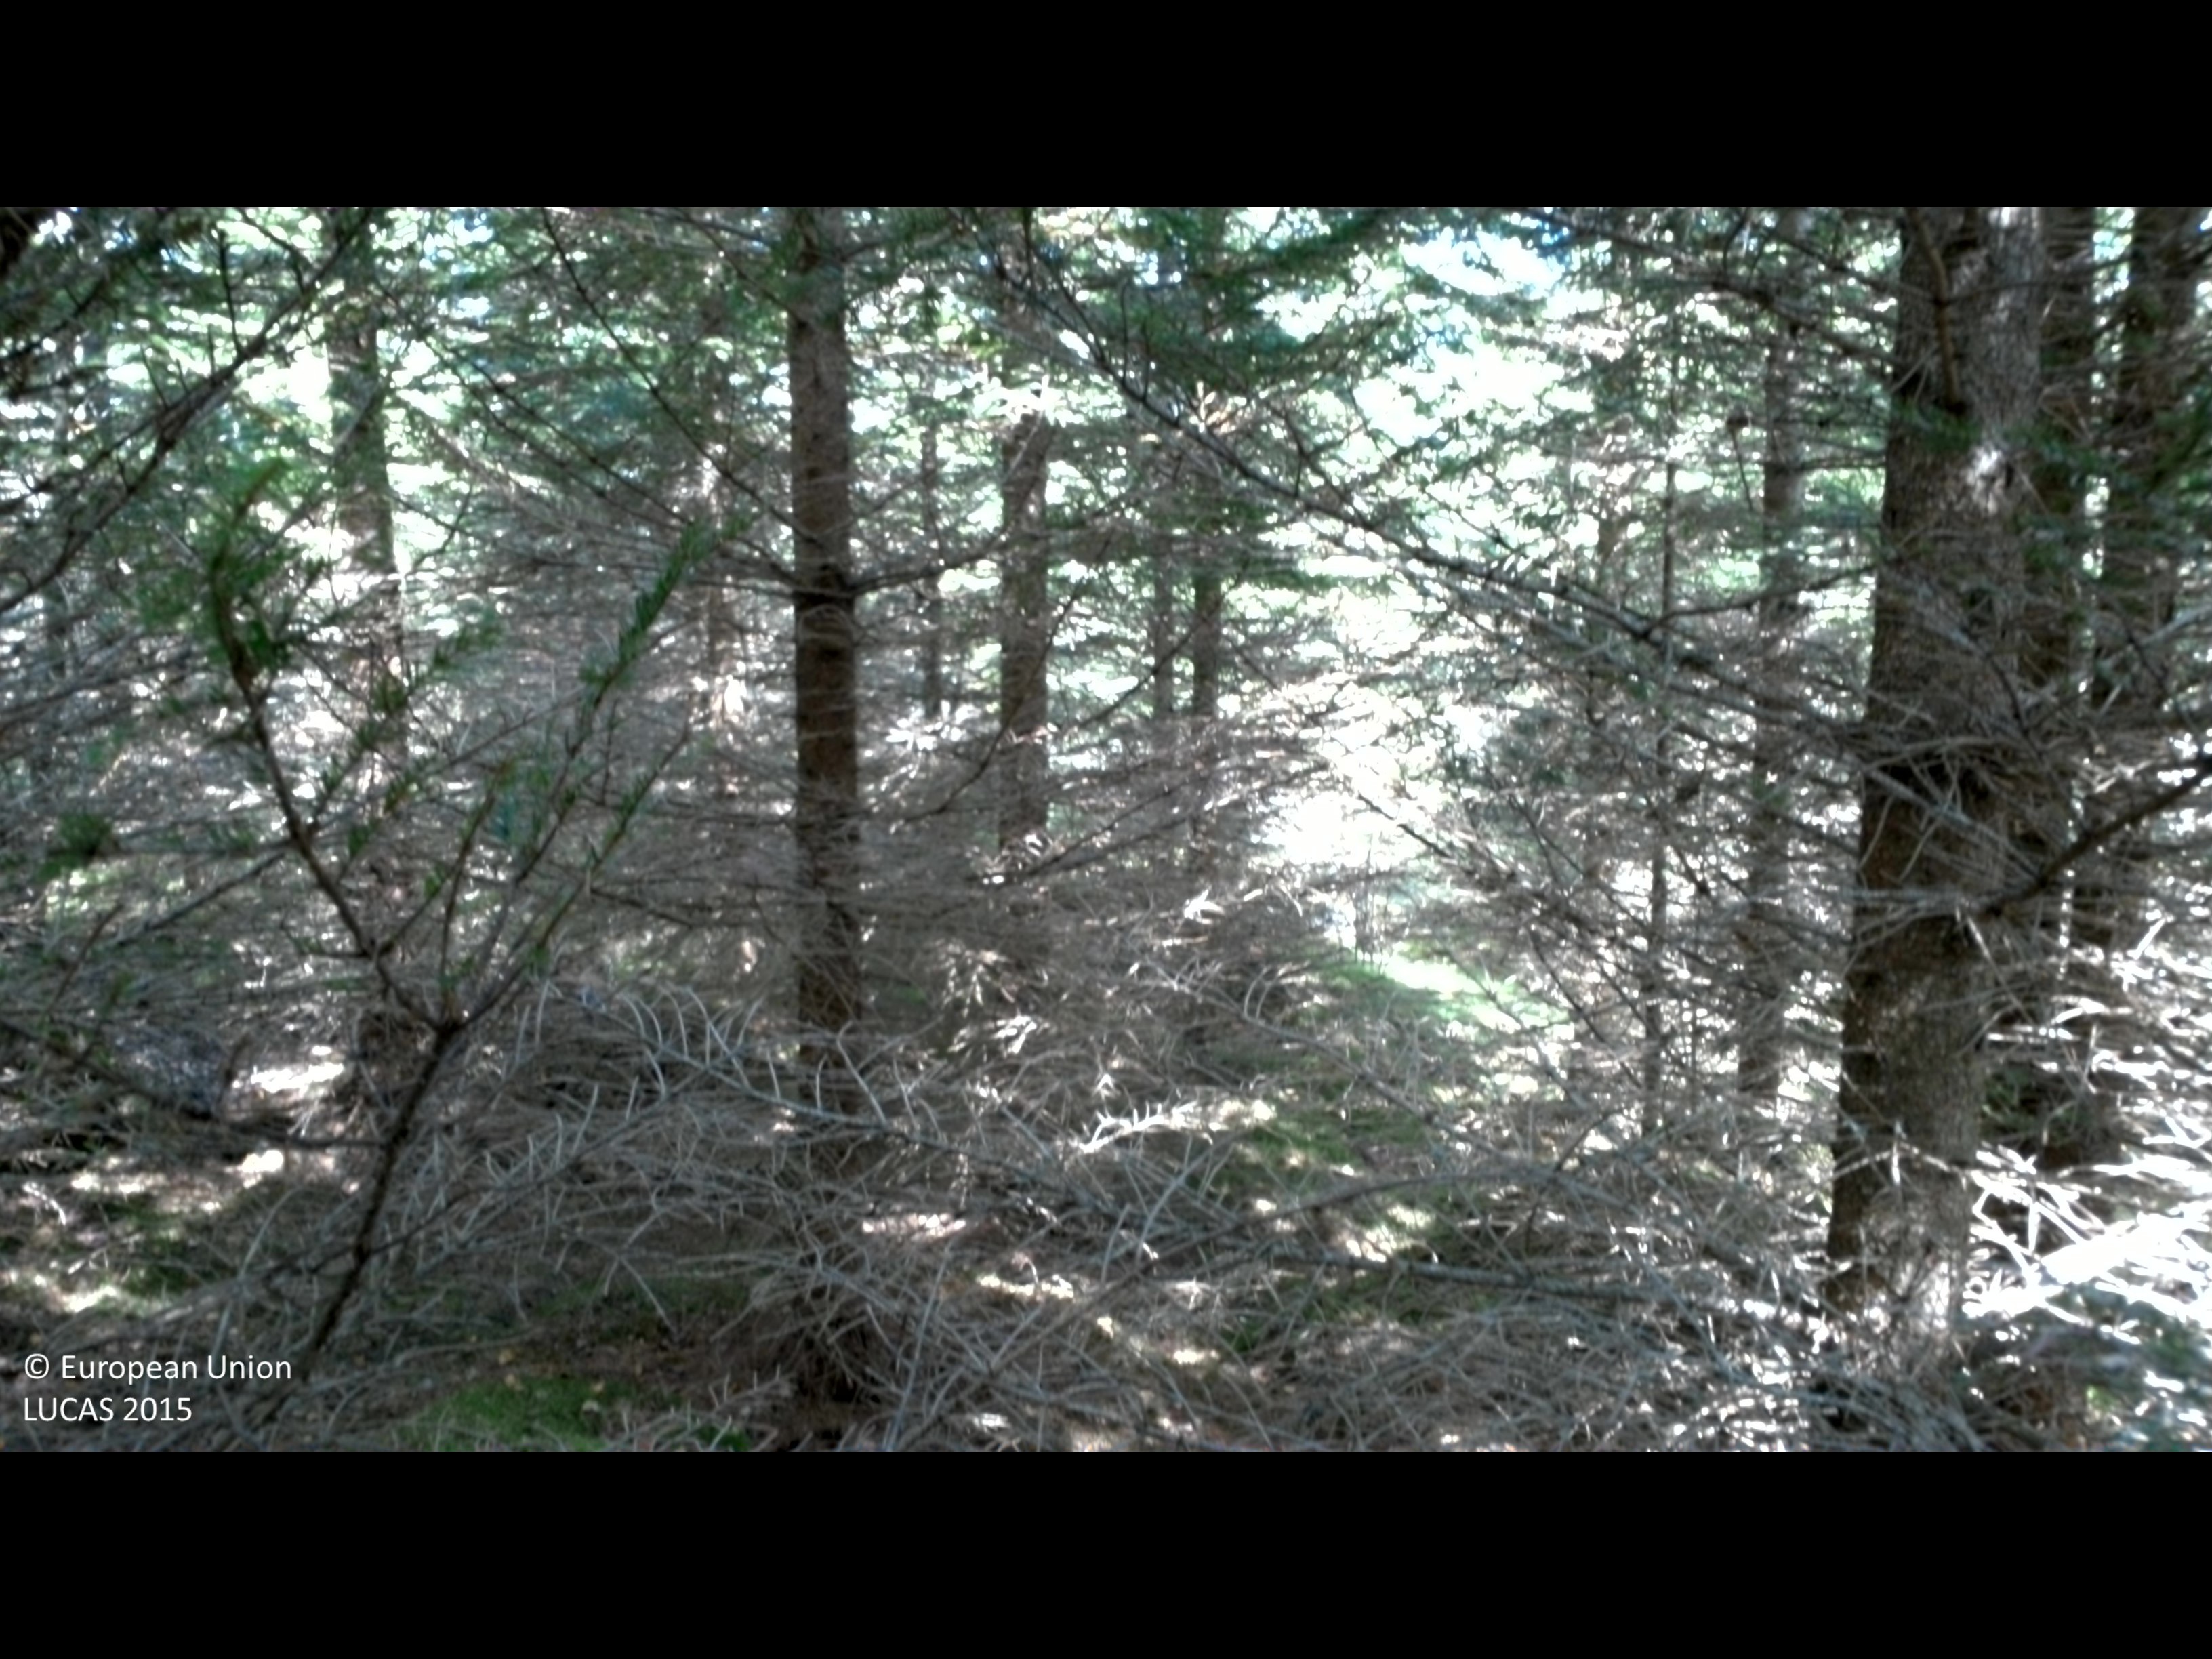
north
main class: Woodland
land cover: Spruce dominated coniferous woodland
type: boreal forest
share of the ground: > 75 %
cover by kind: coniferous forest trees 85 %, lichens and mosses 10 %, broadleaved forest trees 5 %
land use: Forestry
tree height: > 5 m
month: August
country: SE
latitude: 56.3536
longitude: 14.7072
